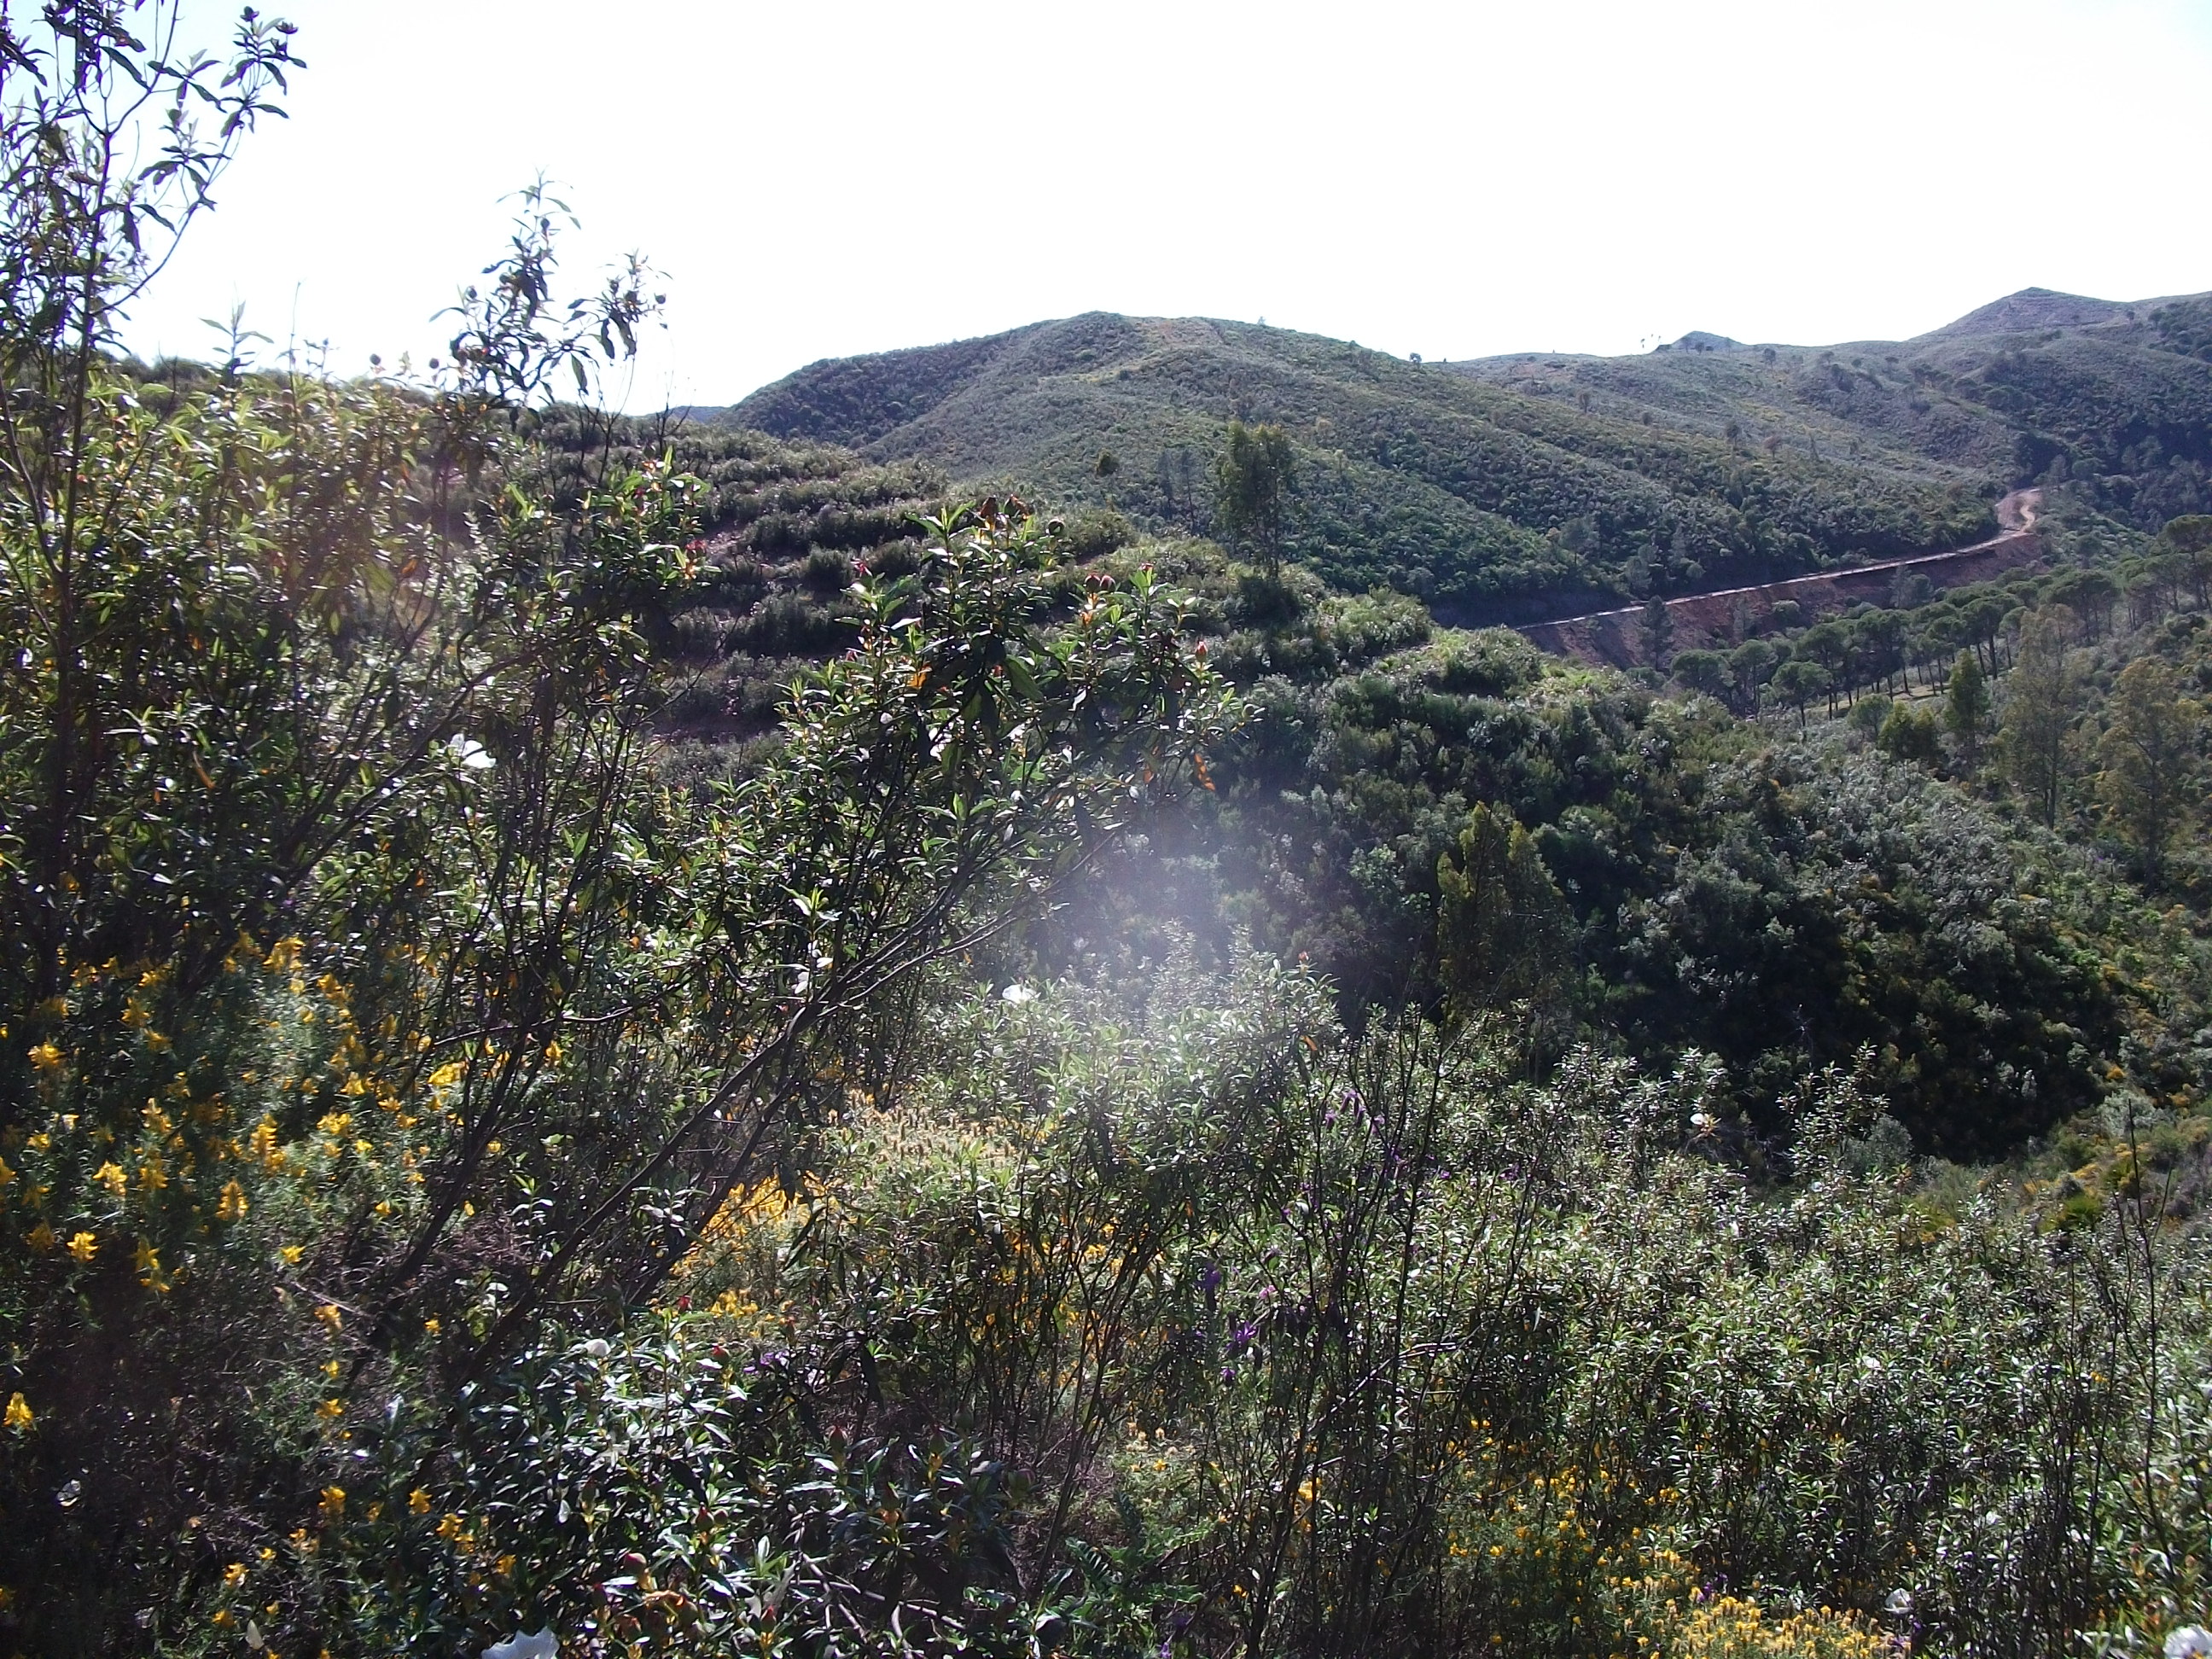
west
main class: Shrubland
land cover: Shrubland without tree cover
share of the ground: > 75 %
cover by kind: shrubs 100 %
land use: Semi-natural and natural areas not in use
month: April
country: ES
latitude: 37.6380
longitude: -6.5265
